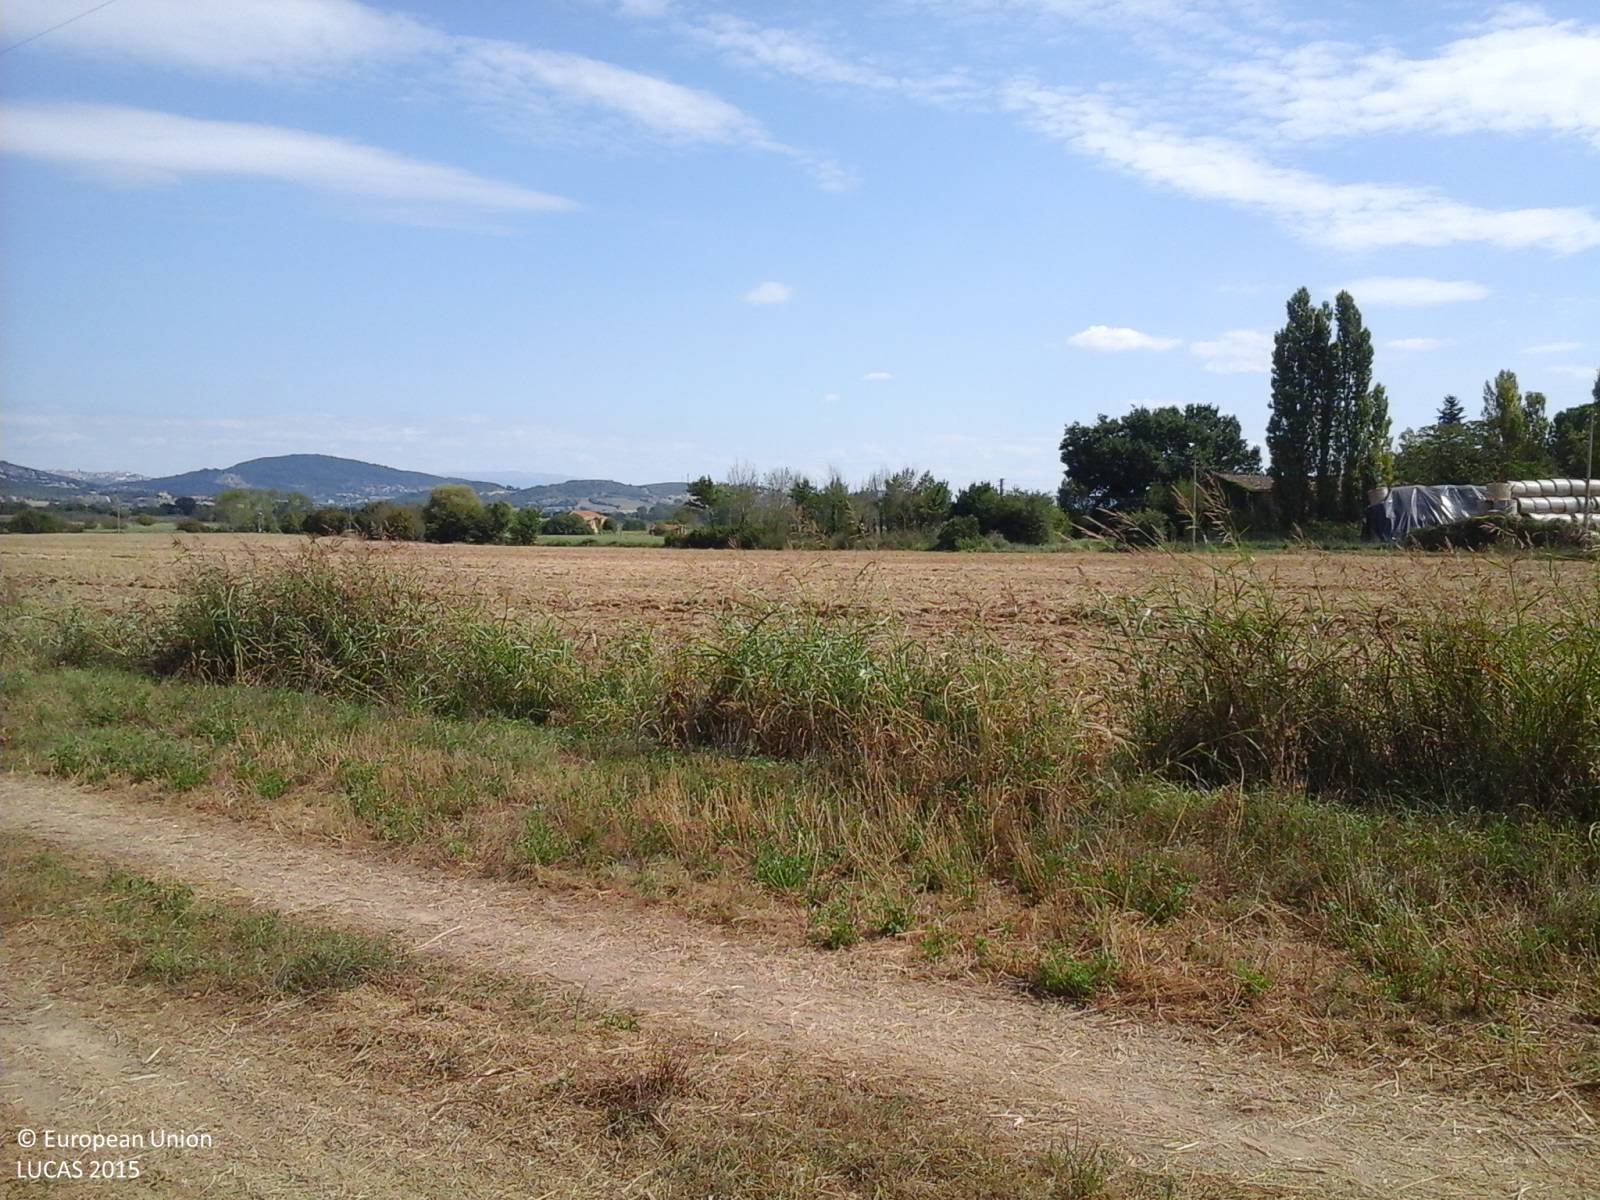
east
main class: Grassland
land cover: Grassland without tree/shrub cover
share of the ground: 50 - 75 %
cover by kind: herbaceous plants 100 %
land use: Agriculture (excluding fallow land and kitchen gardens)
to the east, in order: Grassland without tree/shrub cover; Tracks; Grass margins; Ditches and canals; Electric lines; Grass margins; Mixed cereals for fodder; Ditches and canals; Mixed cereals for fodder; Ditches and canals; Mixed cereals for fodder; Ditches and canals; Mixed cereals for fodder
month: September
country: IT
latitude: 43.0989
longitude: 12.2419
